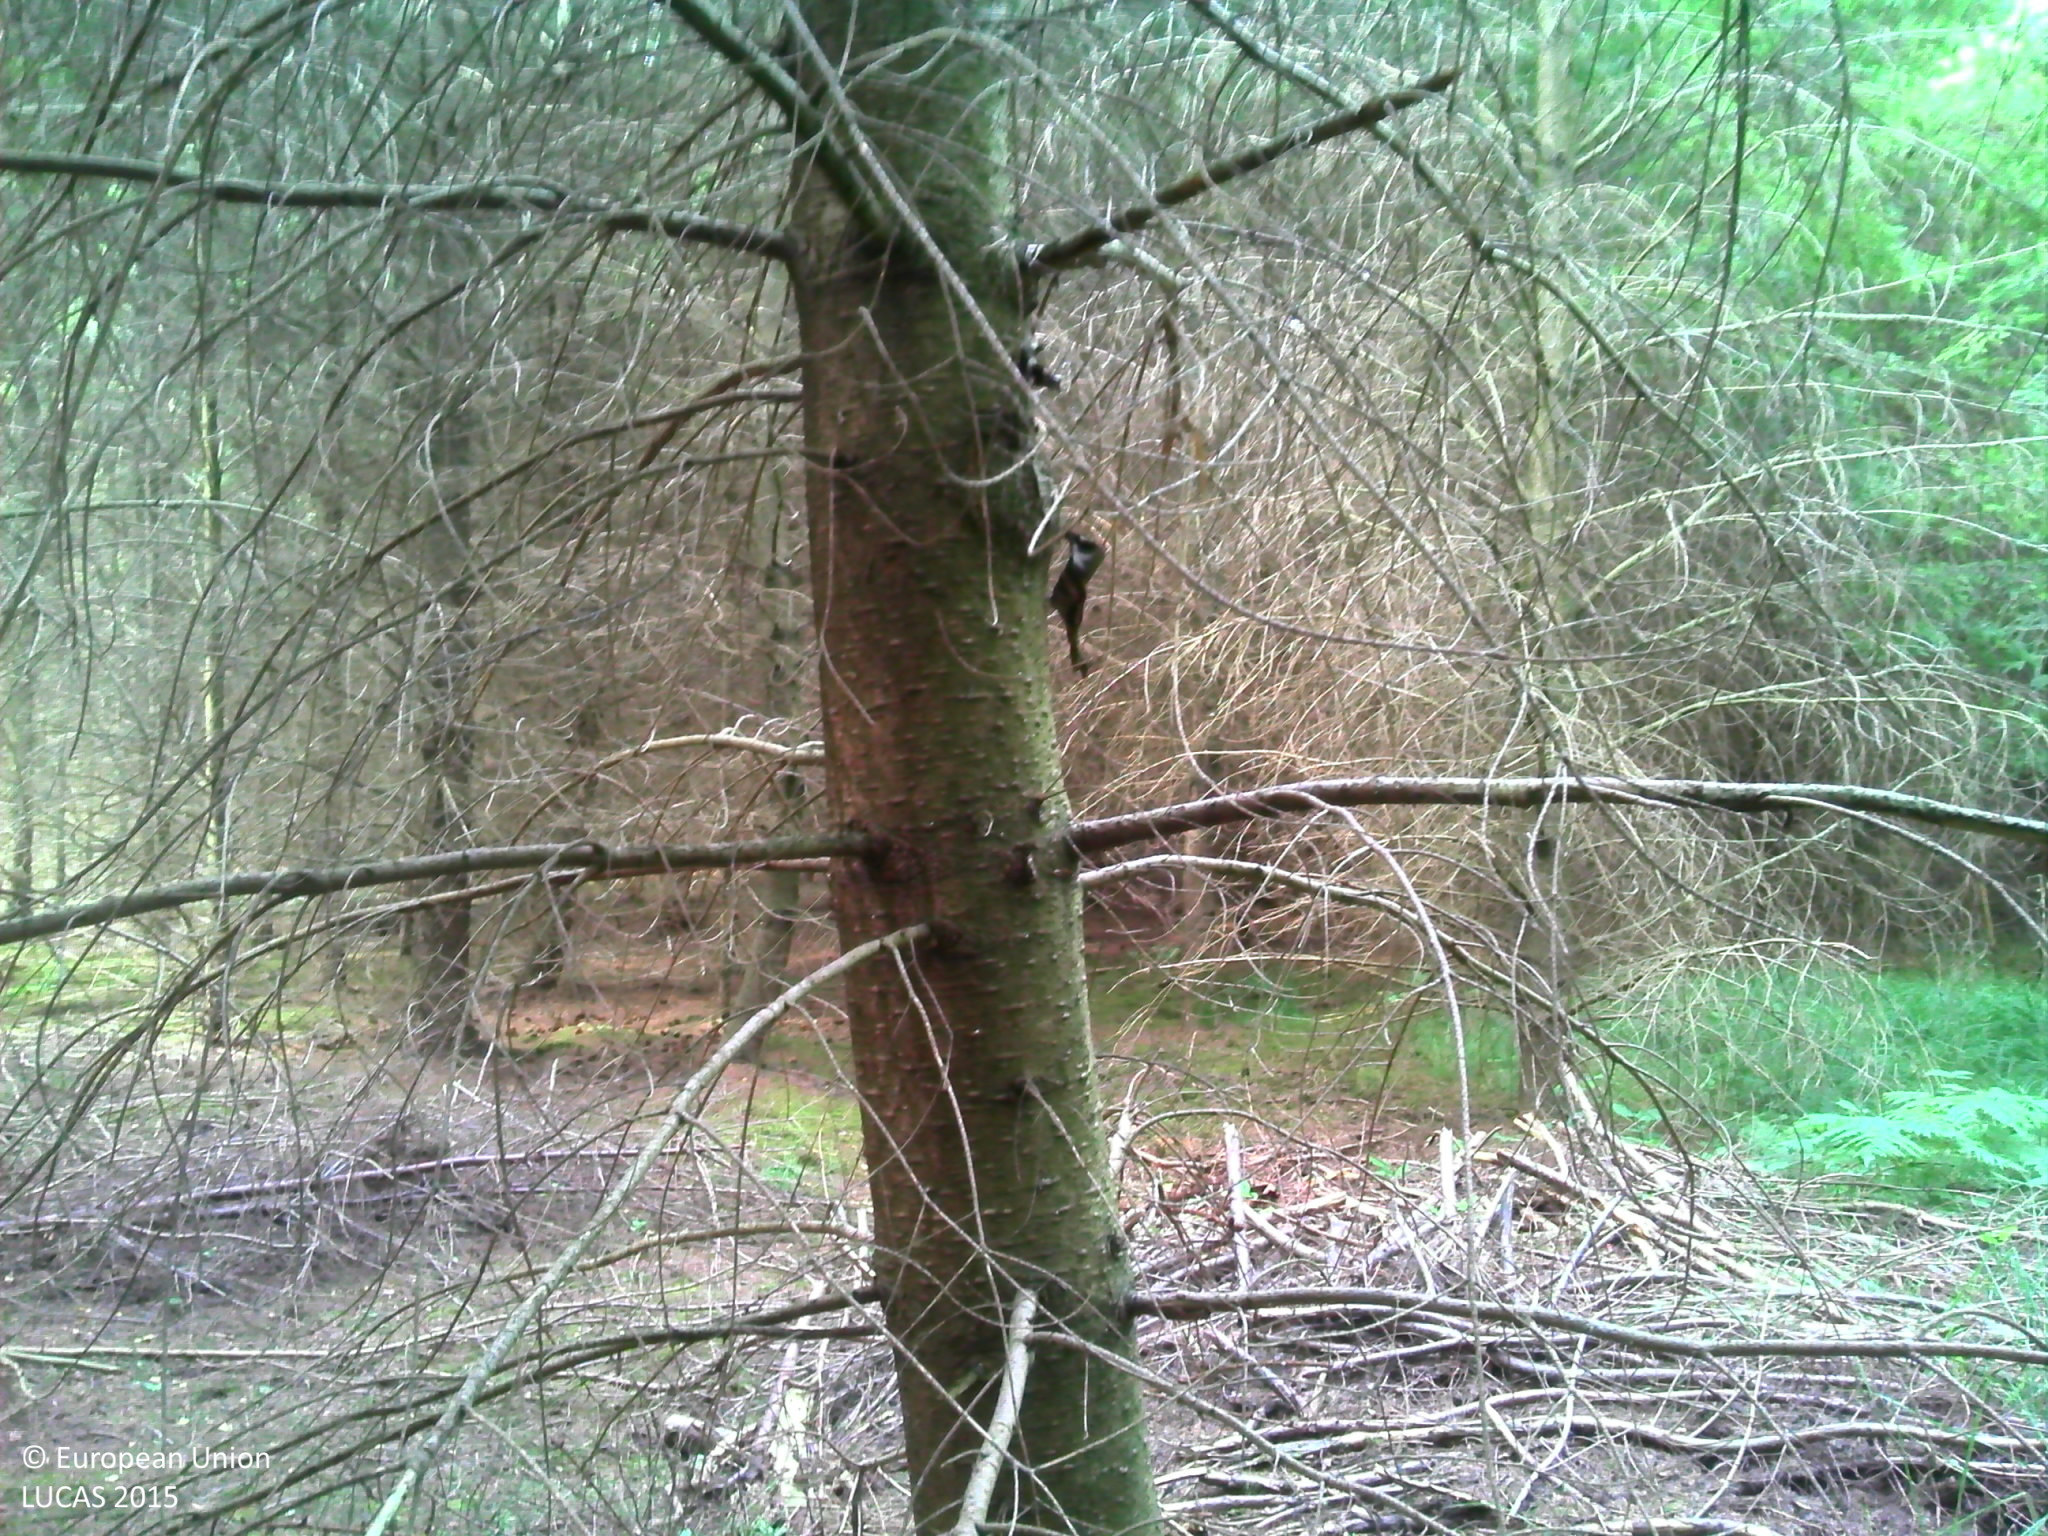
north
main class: Woodland
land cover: Spruce dominated coniferous woodland
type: mesophytic deciduous forest
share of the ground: > 75 %
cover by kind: coniferous forest trees 95 %, herbaceous plants 5 %
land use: Forestry
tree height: > 5 m
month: August
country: FR
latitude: 48.5111
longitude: -0.1976
